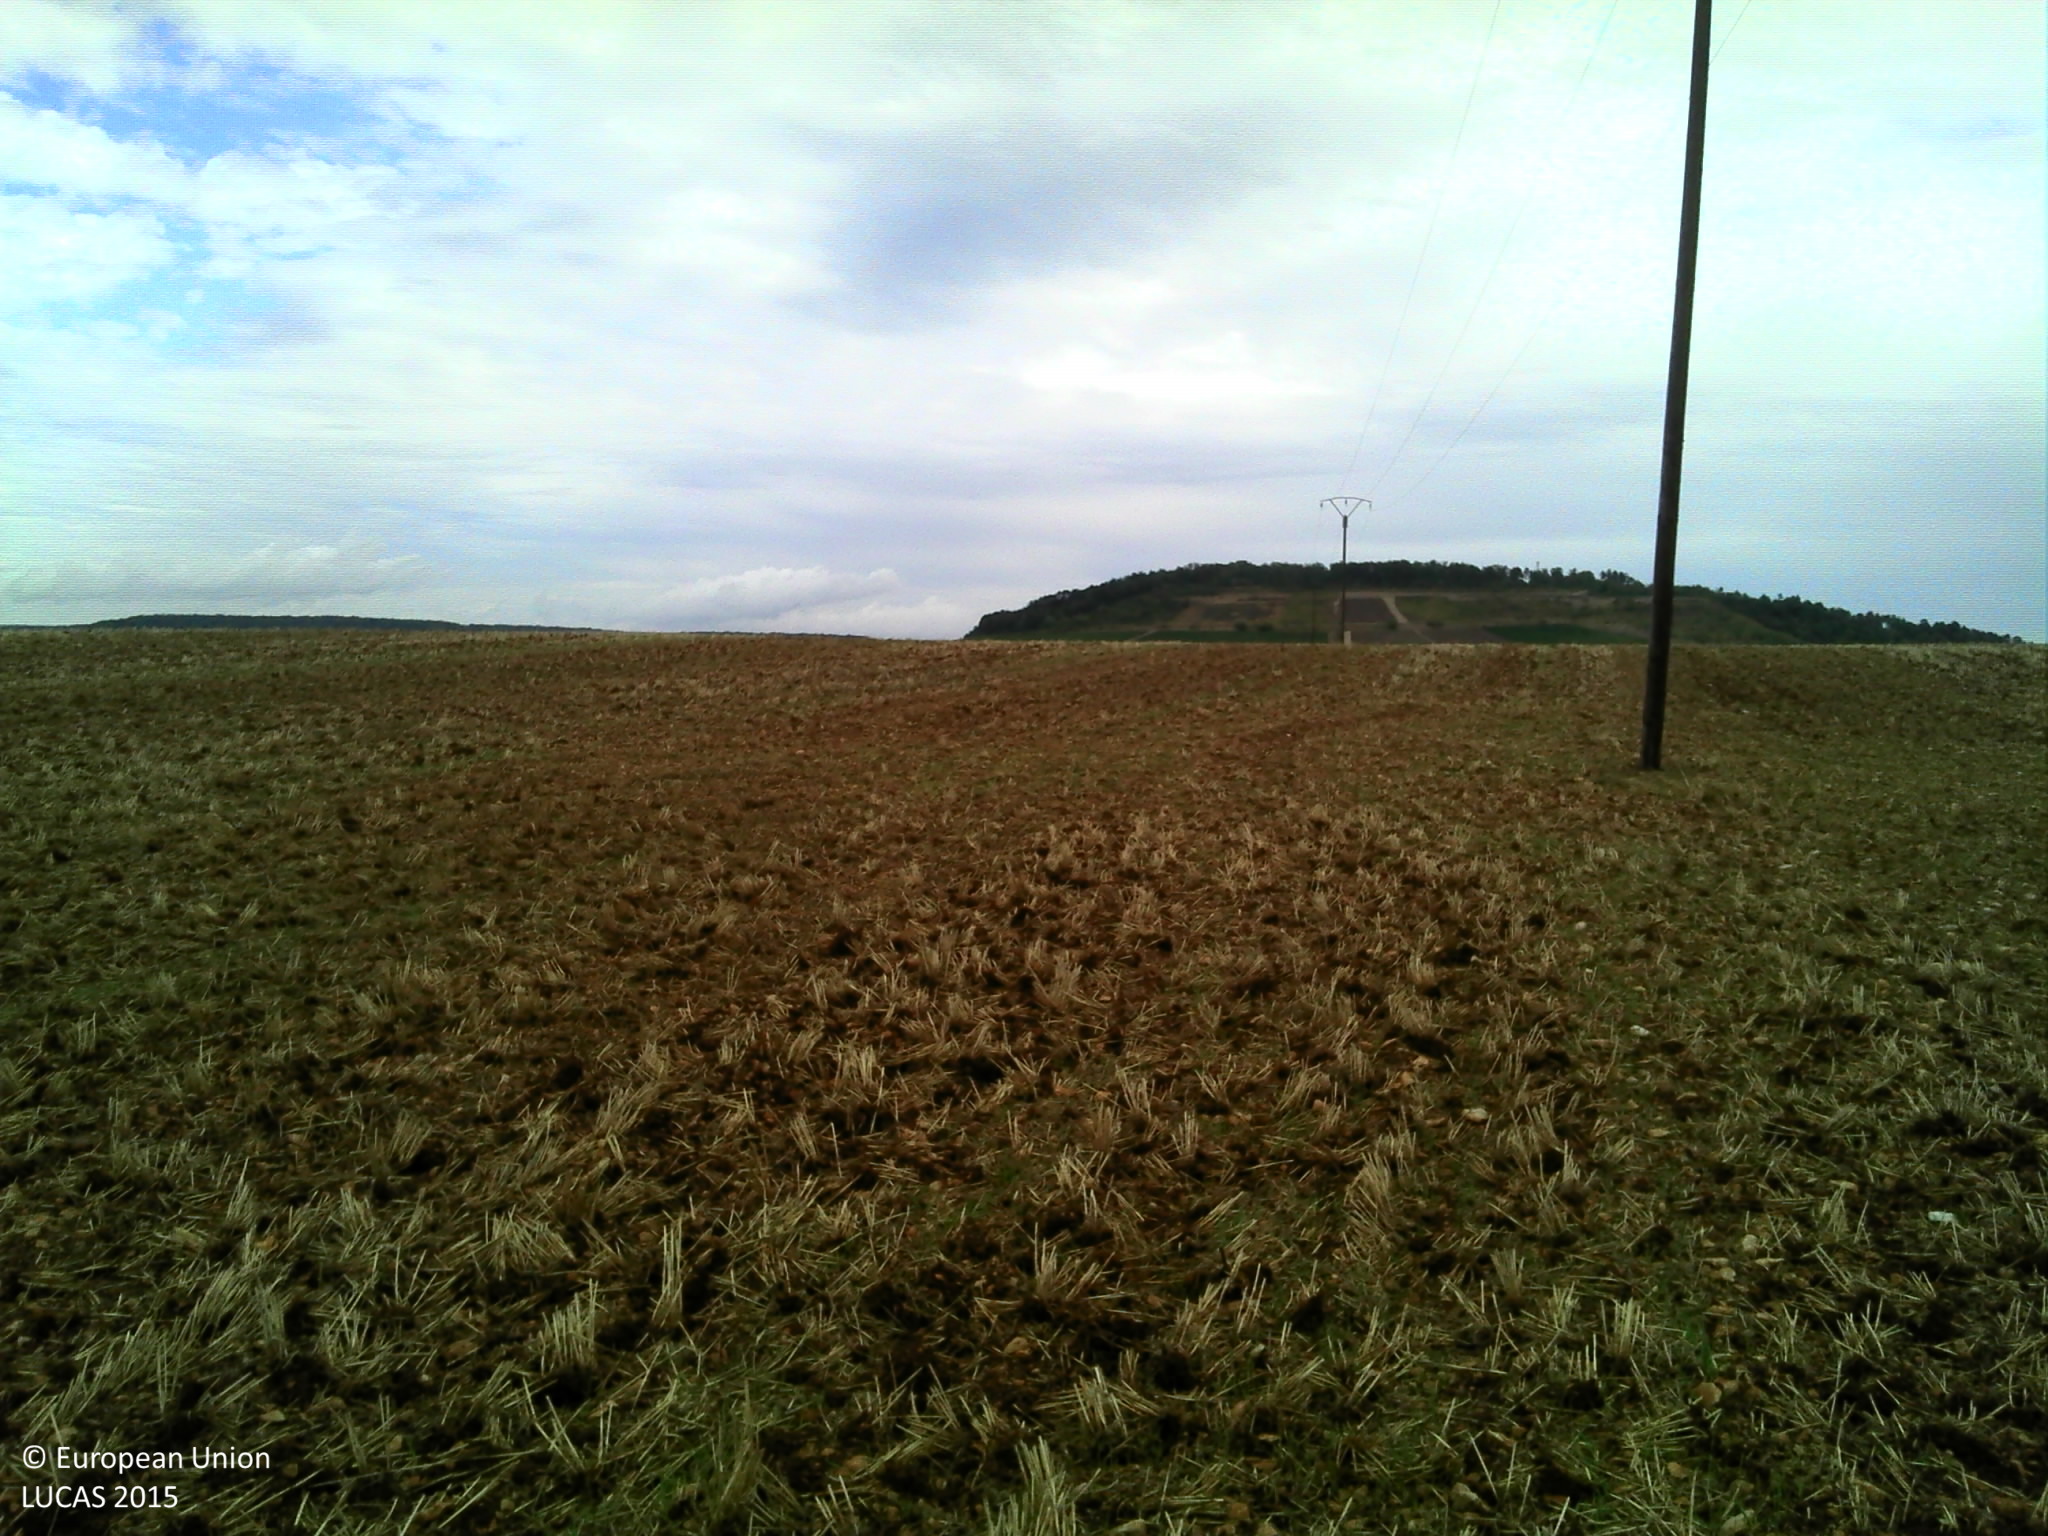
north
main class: Cropland
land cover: Common wheat
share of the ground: 10 - 25 %
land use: Agriculture (excluding fallow land and kitchen gardens)
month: August
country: FR
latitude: 47.8972
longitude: 4.6884
